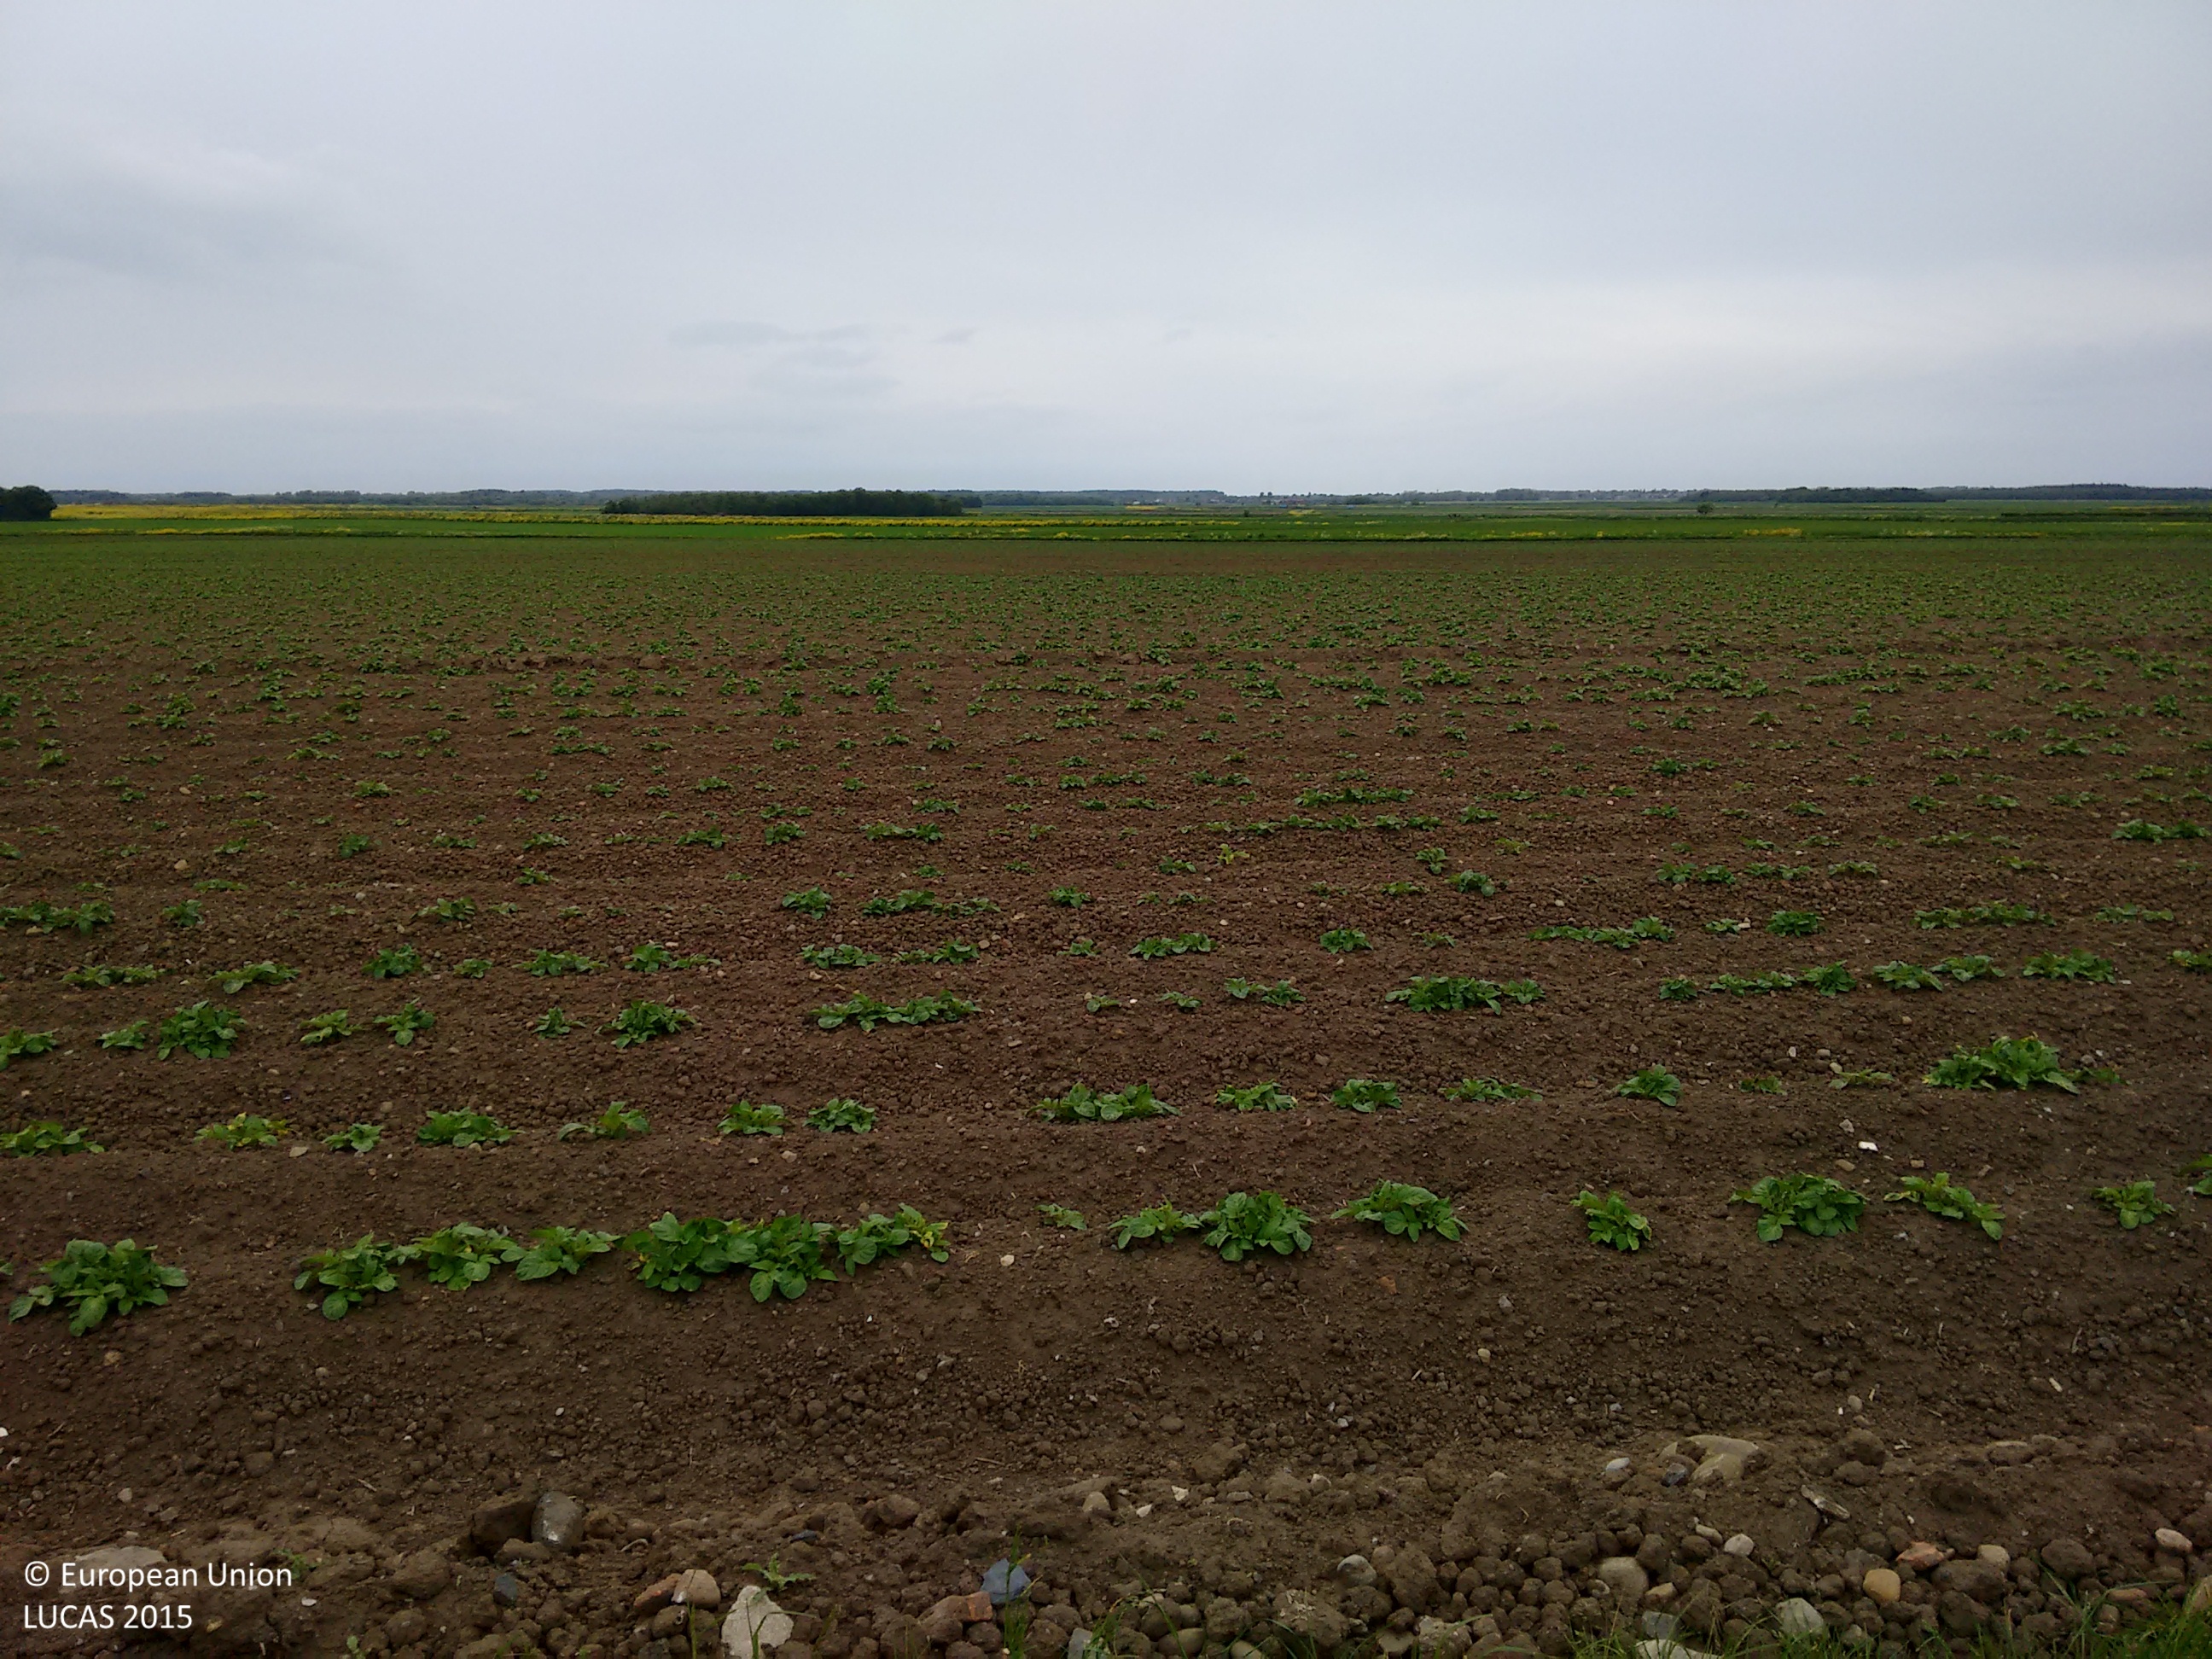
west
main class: Cropland
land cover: Potatoes
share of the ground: 10 - 25 %
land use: Agriculture (excluding fallow land and kitchen gardens)
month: May
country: GB
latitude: 53.5736
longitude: -2.9857
